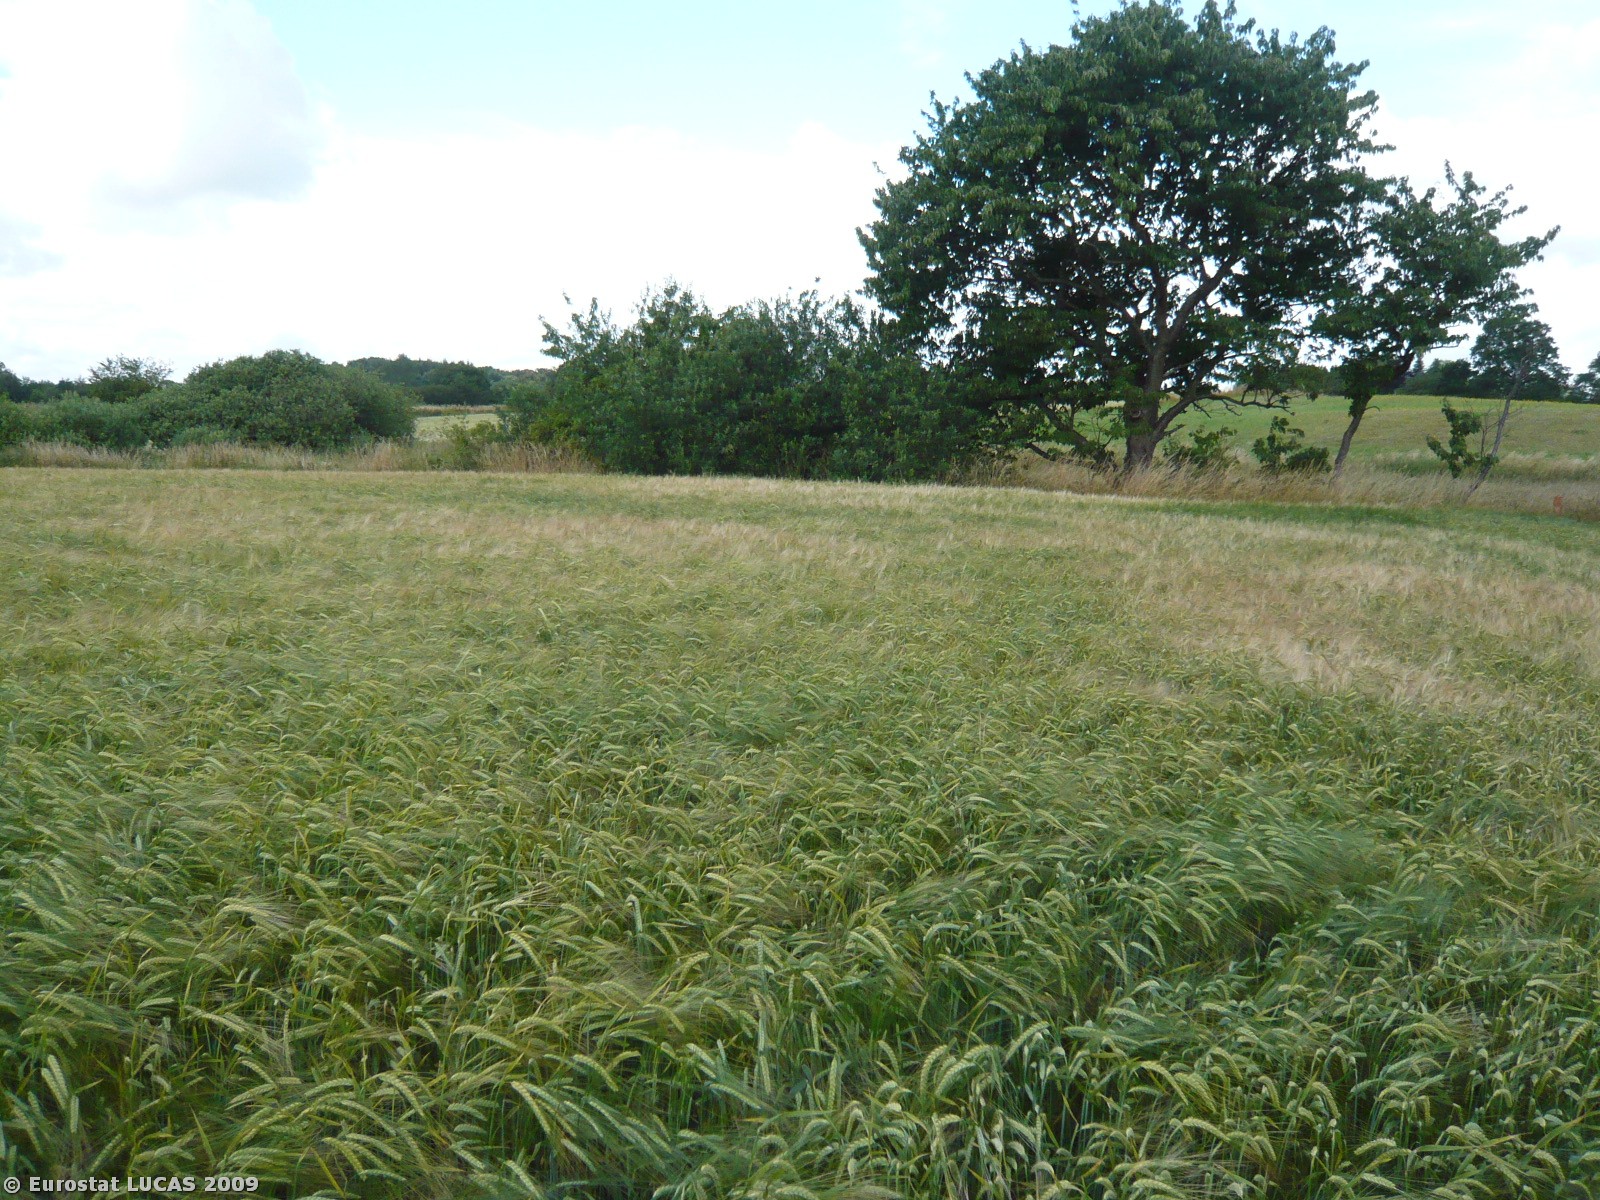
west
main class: Cropland
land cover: Barley
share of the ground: > 75 %
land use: Agriculture (excluding fallow land and kitchen gardens)
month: July
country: DK
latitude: 55.4687
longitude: 10.1422
